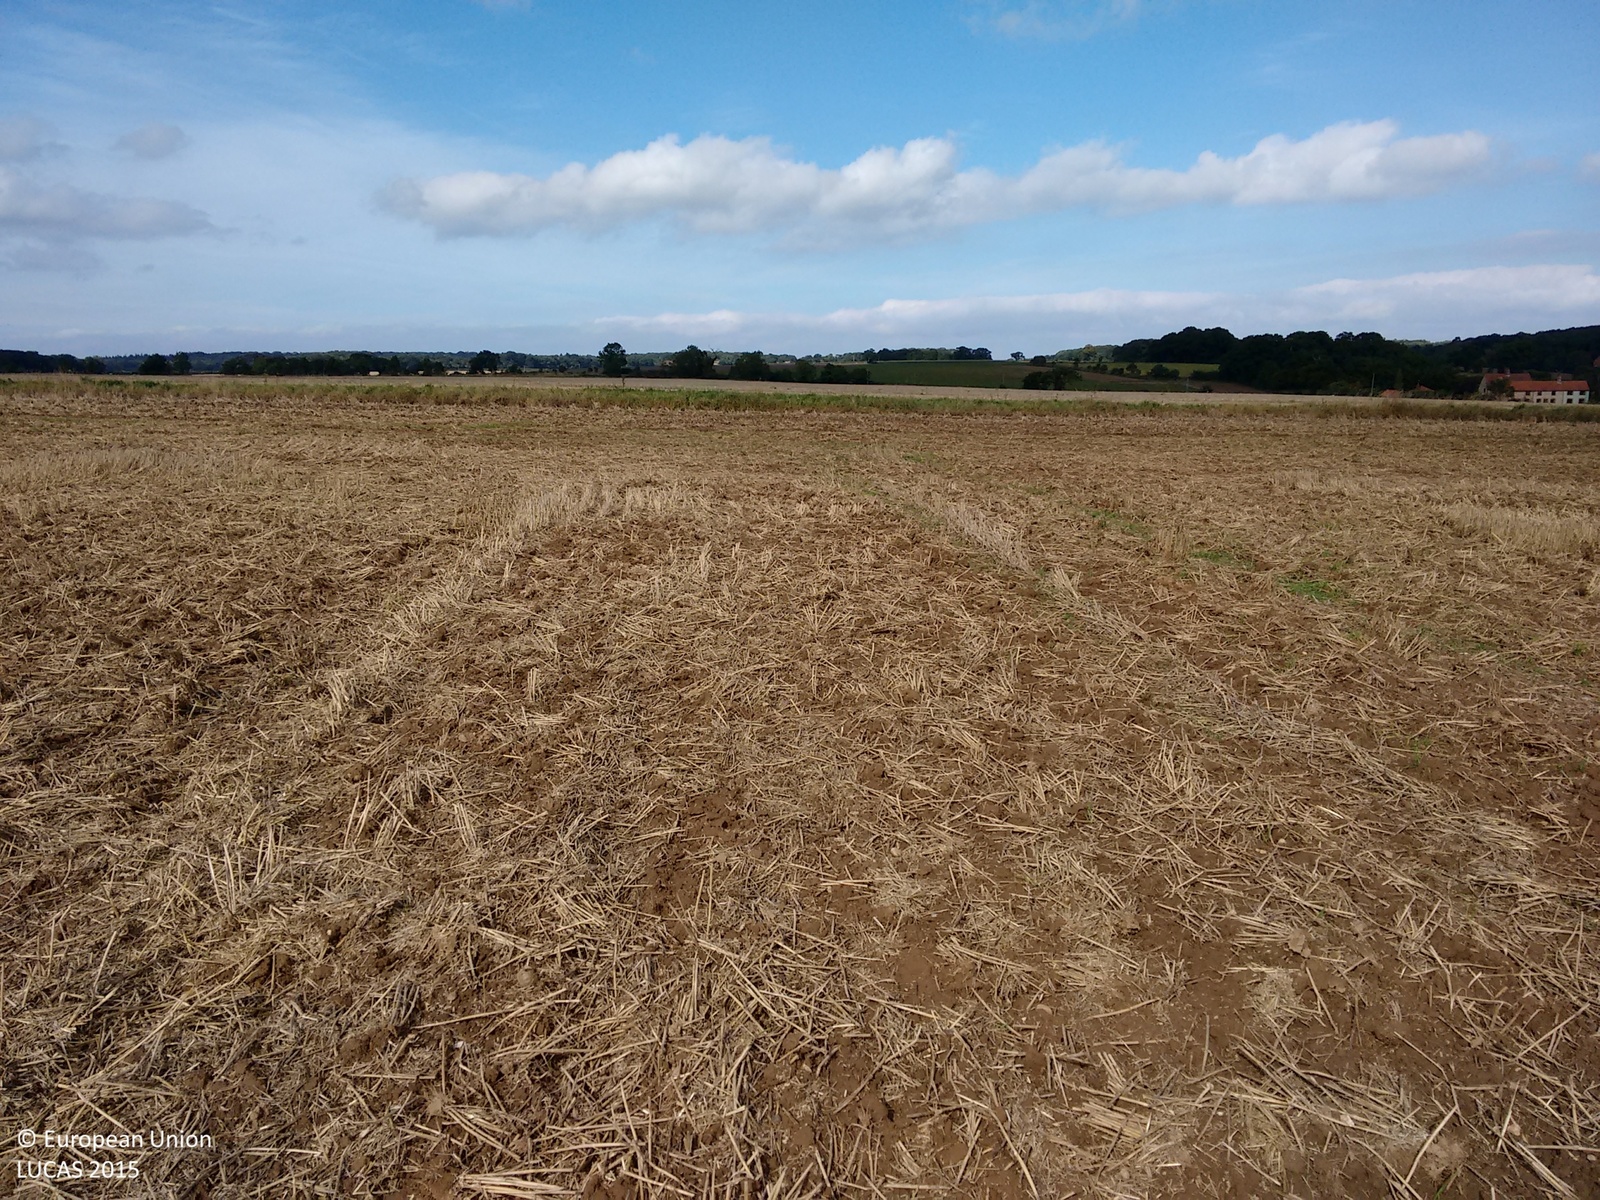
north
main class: Cropland
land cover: Common wheat
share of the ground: > 75 %
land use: Agriculture (excluding fallow land and kitchen gardens)
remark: Harvested field
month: September
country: GB
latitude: 52.8884
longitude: 1.2851
